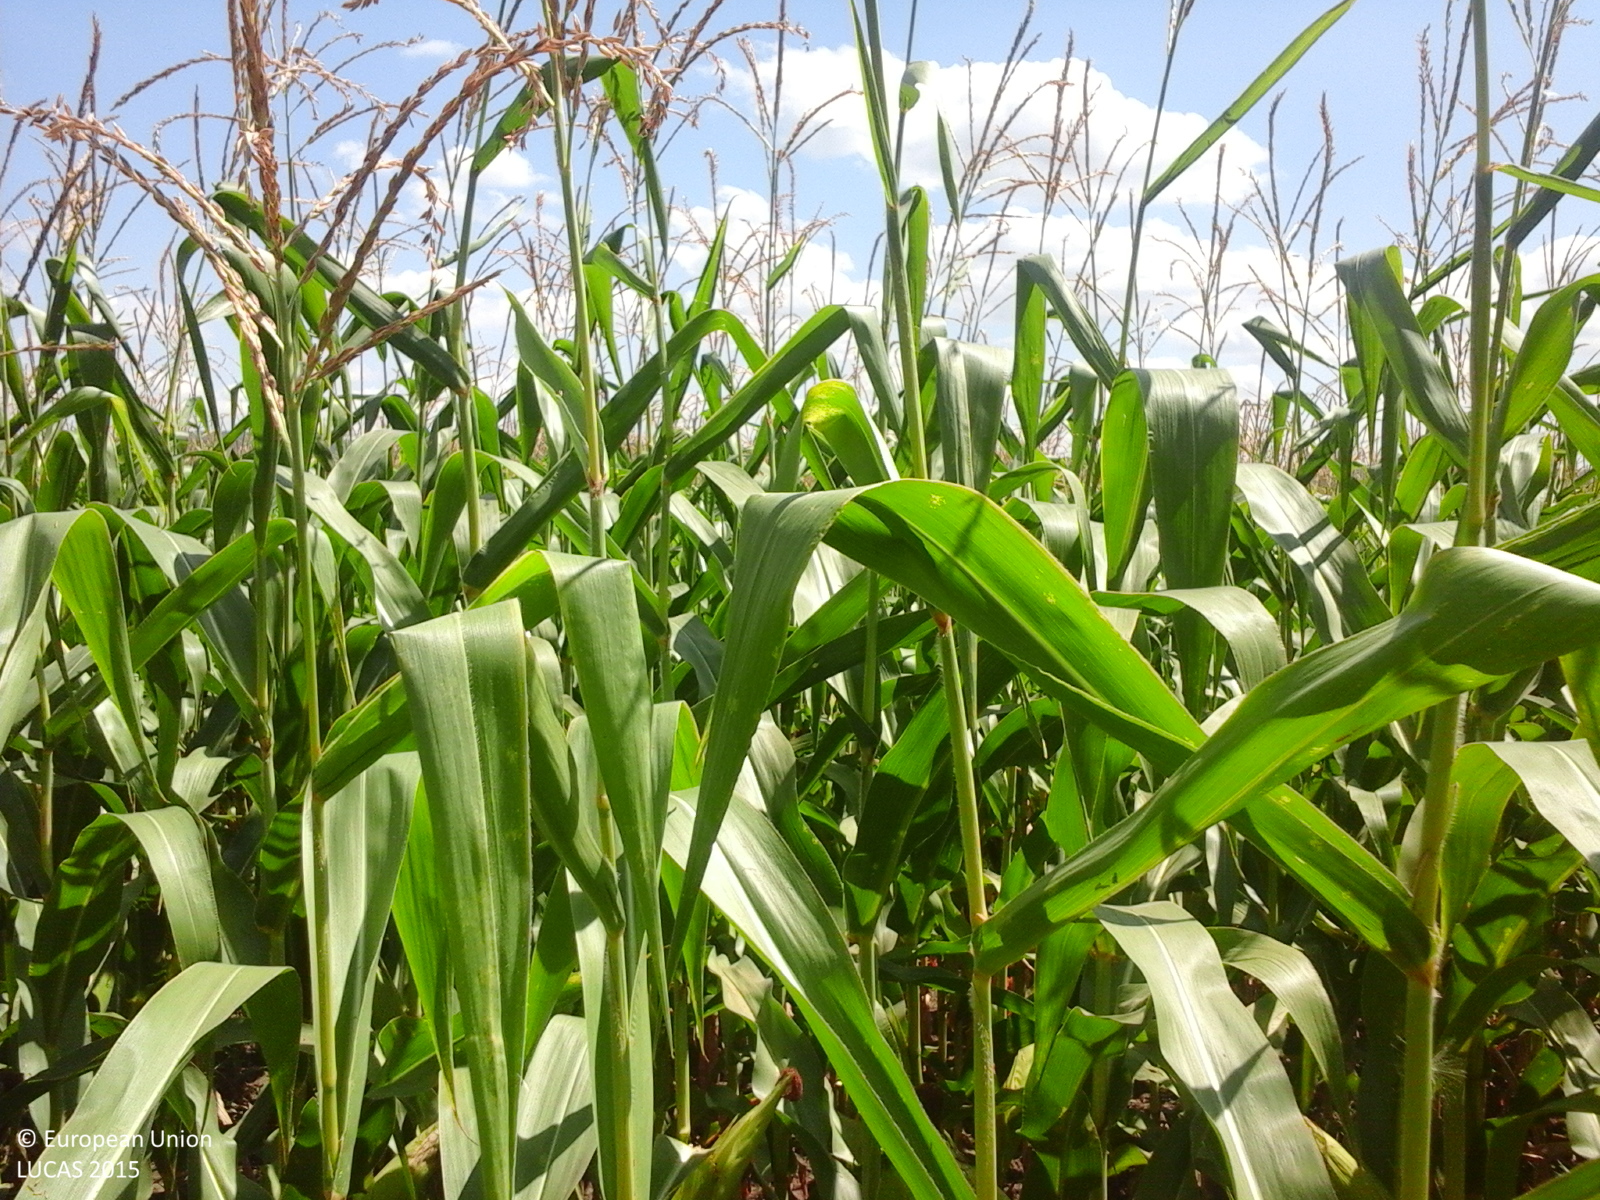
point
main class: Cropland
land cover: Maize
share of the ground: > 75 %
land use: Agriculture (excluding fallow land and kitchen gardens)
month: July
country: RO
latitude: 46.5529
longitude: 27.8203
